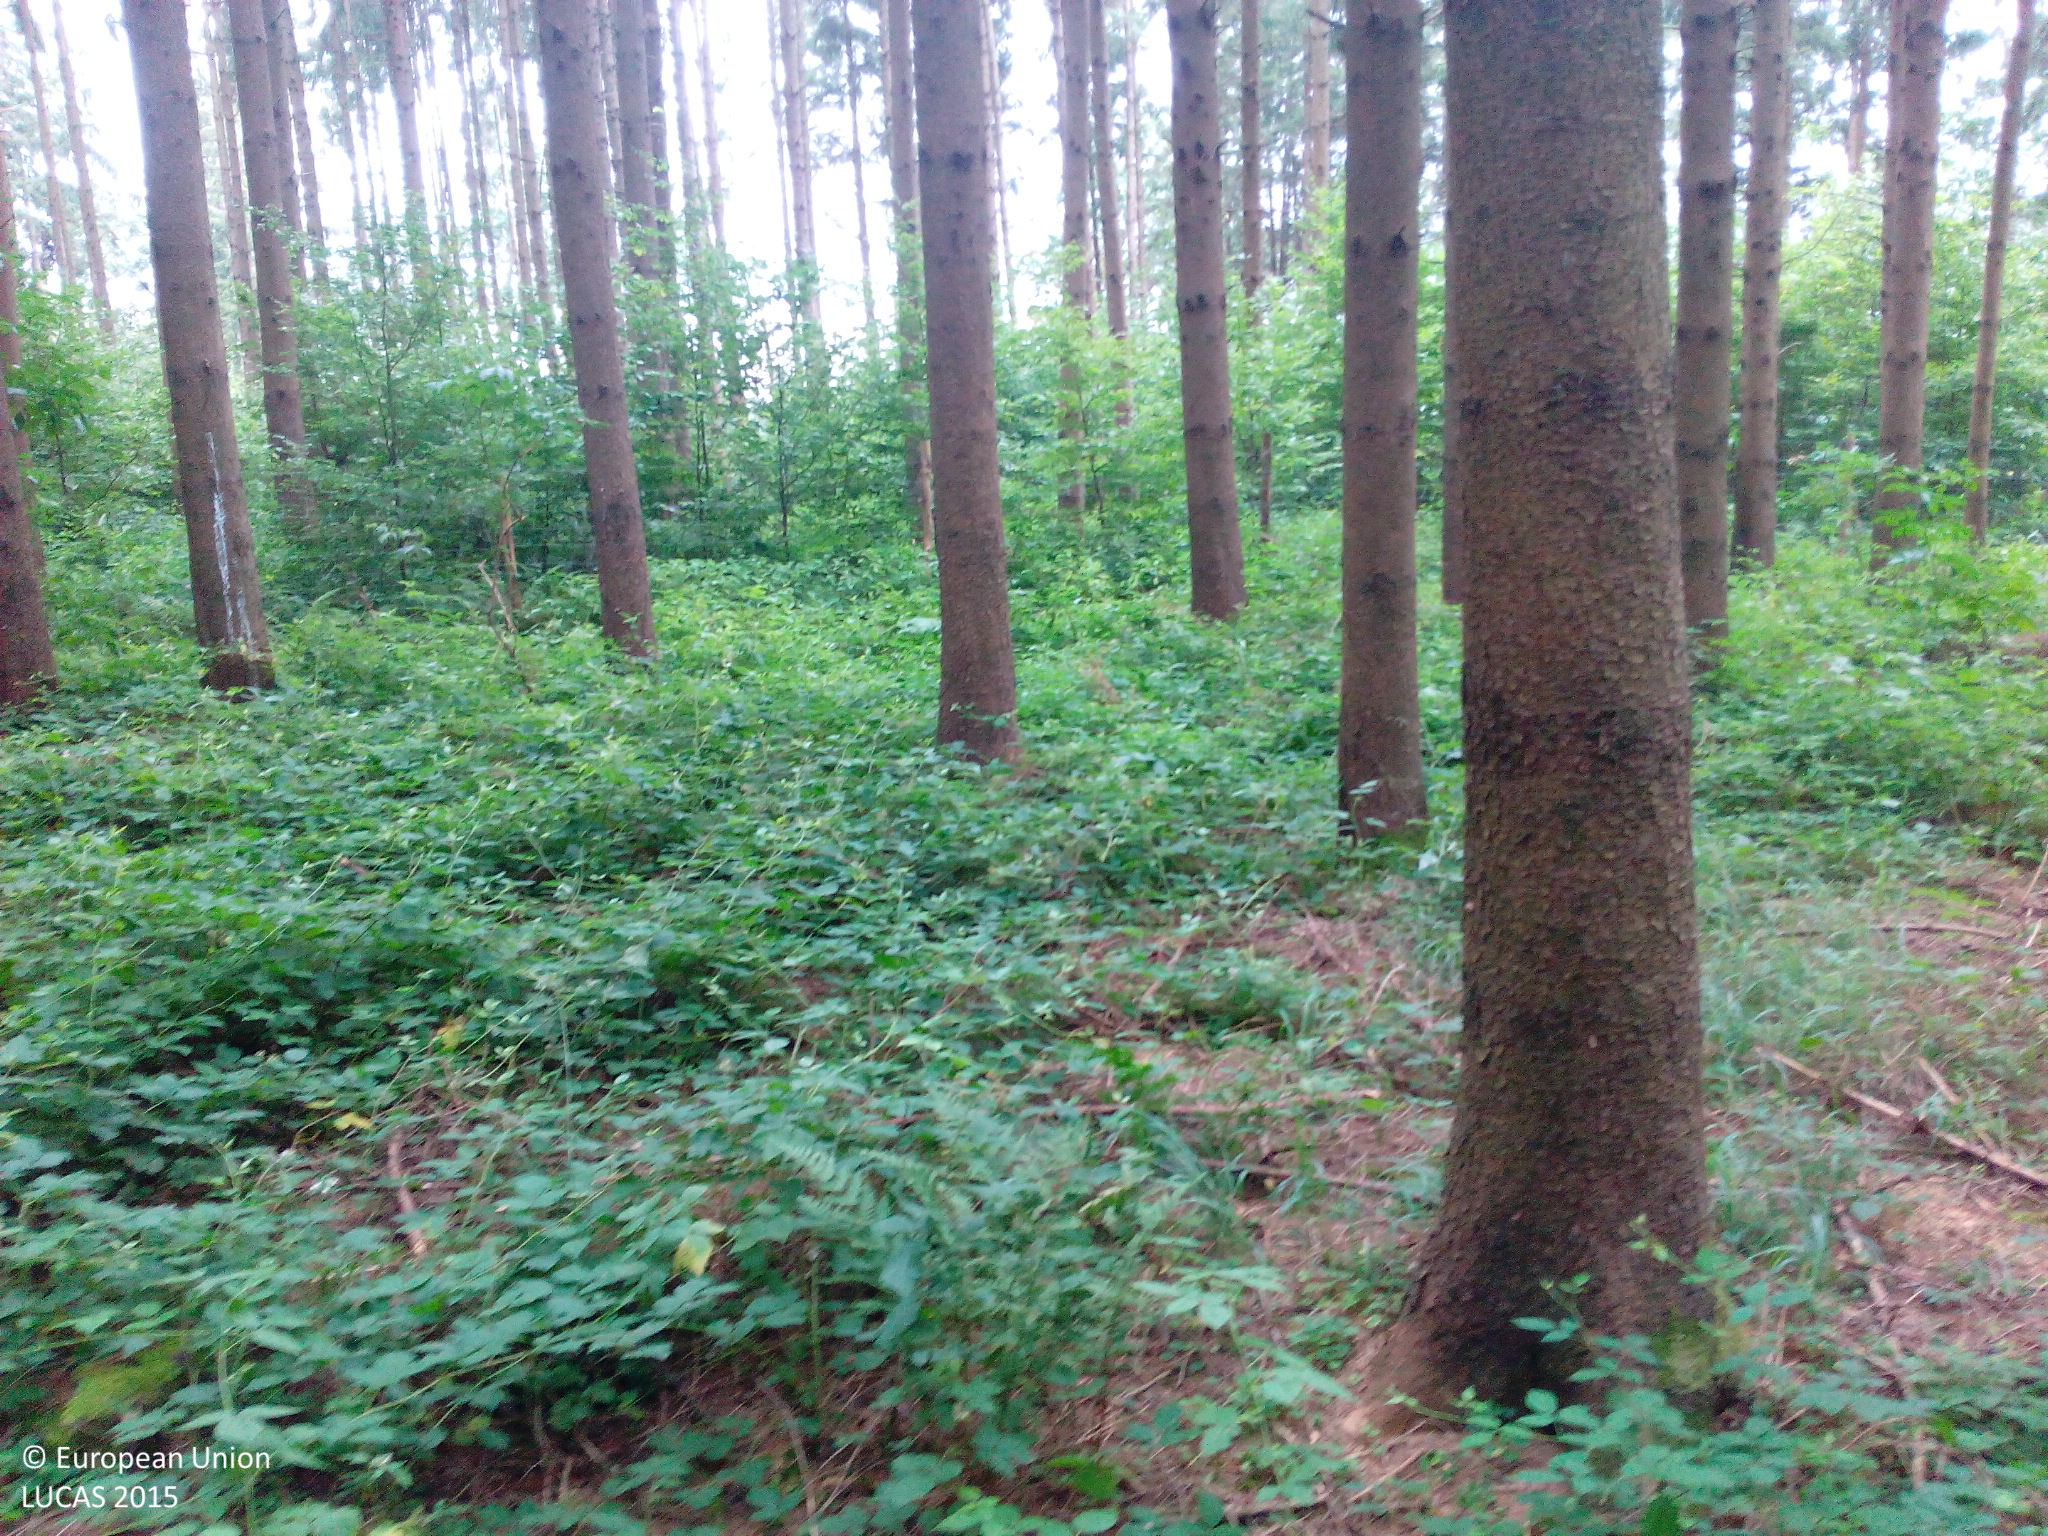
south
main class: Woodland
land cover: Spruce dominated coniferous woodland
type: hemiboreal forest and nemoral coniferous forest and mixed broadleaved-coniferous forest
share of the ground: > 75 %
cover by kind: coniferous forest trees 100 %
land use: Forestry
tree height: > 5 m
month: July
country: DE
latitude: 48.0934
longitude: 10.9527
